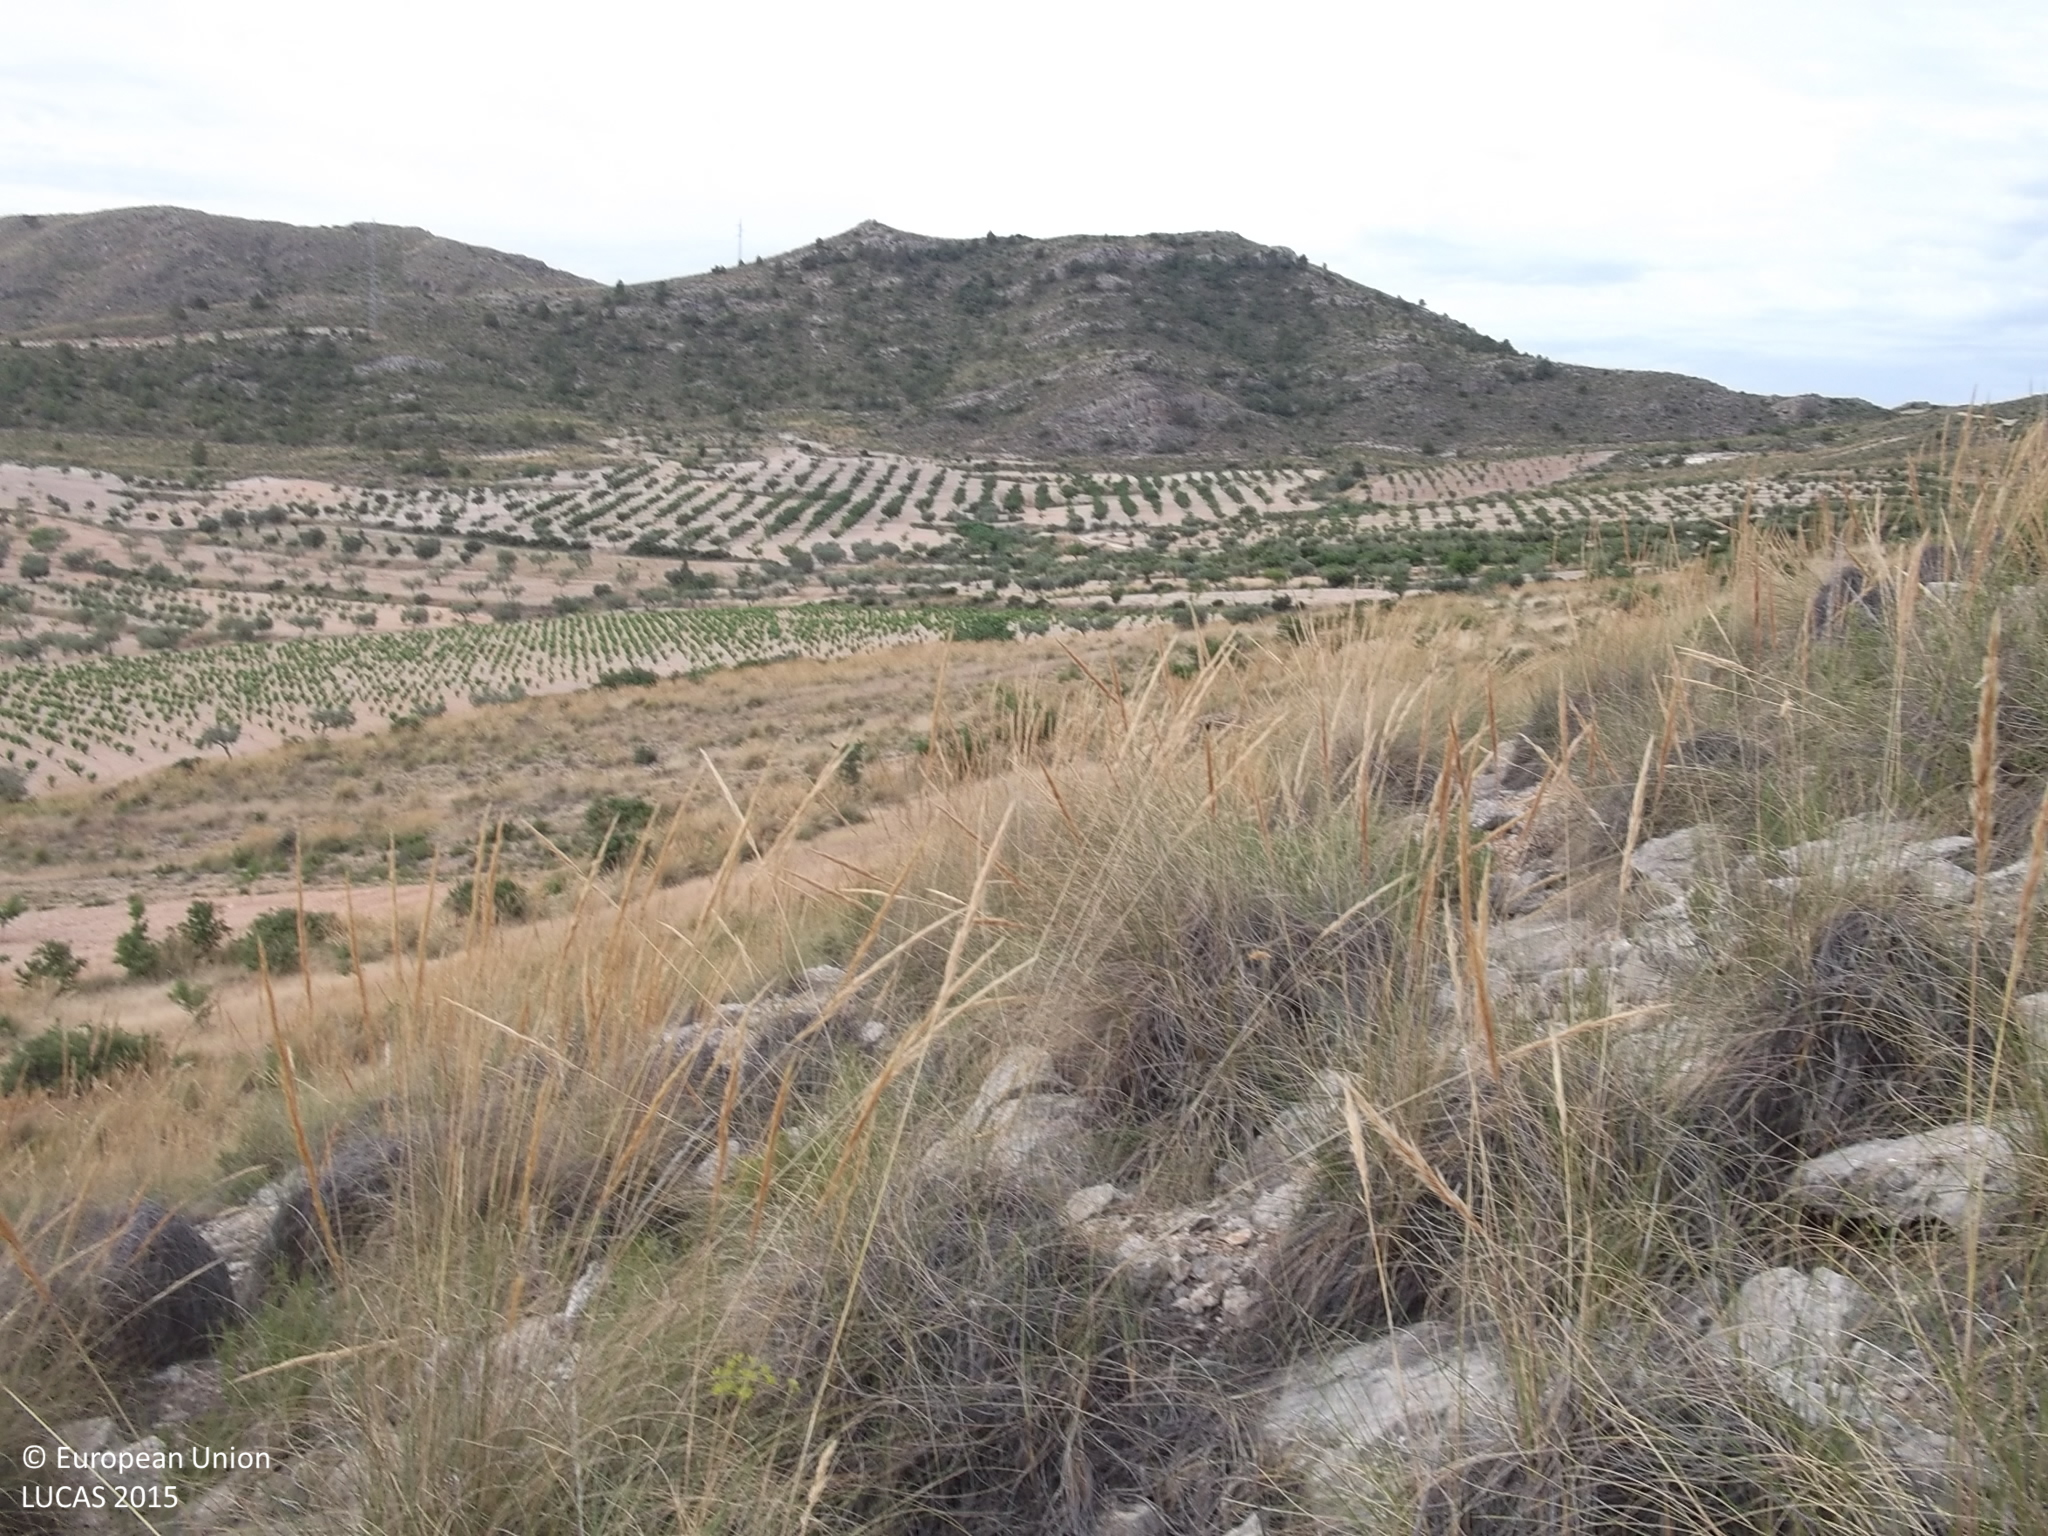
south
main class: Shrubland
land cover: Shrubland without tree cover
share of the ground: 25 - 50 %
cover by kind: consolidated bare surface 40 %, shrubs 30 %, herbaceous plants 30 %
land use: Semi-natural and natural areas not in use
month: May
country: ES
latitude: 38.5071
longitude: -1.3786
